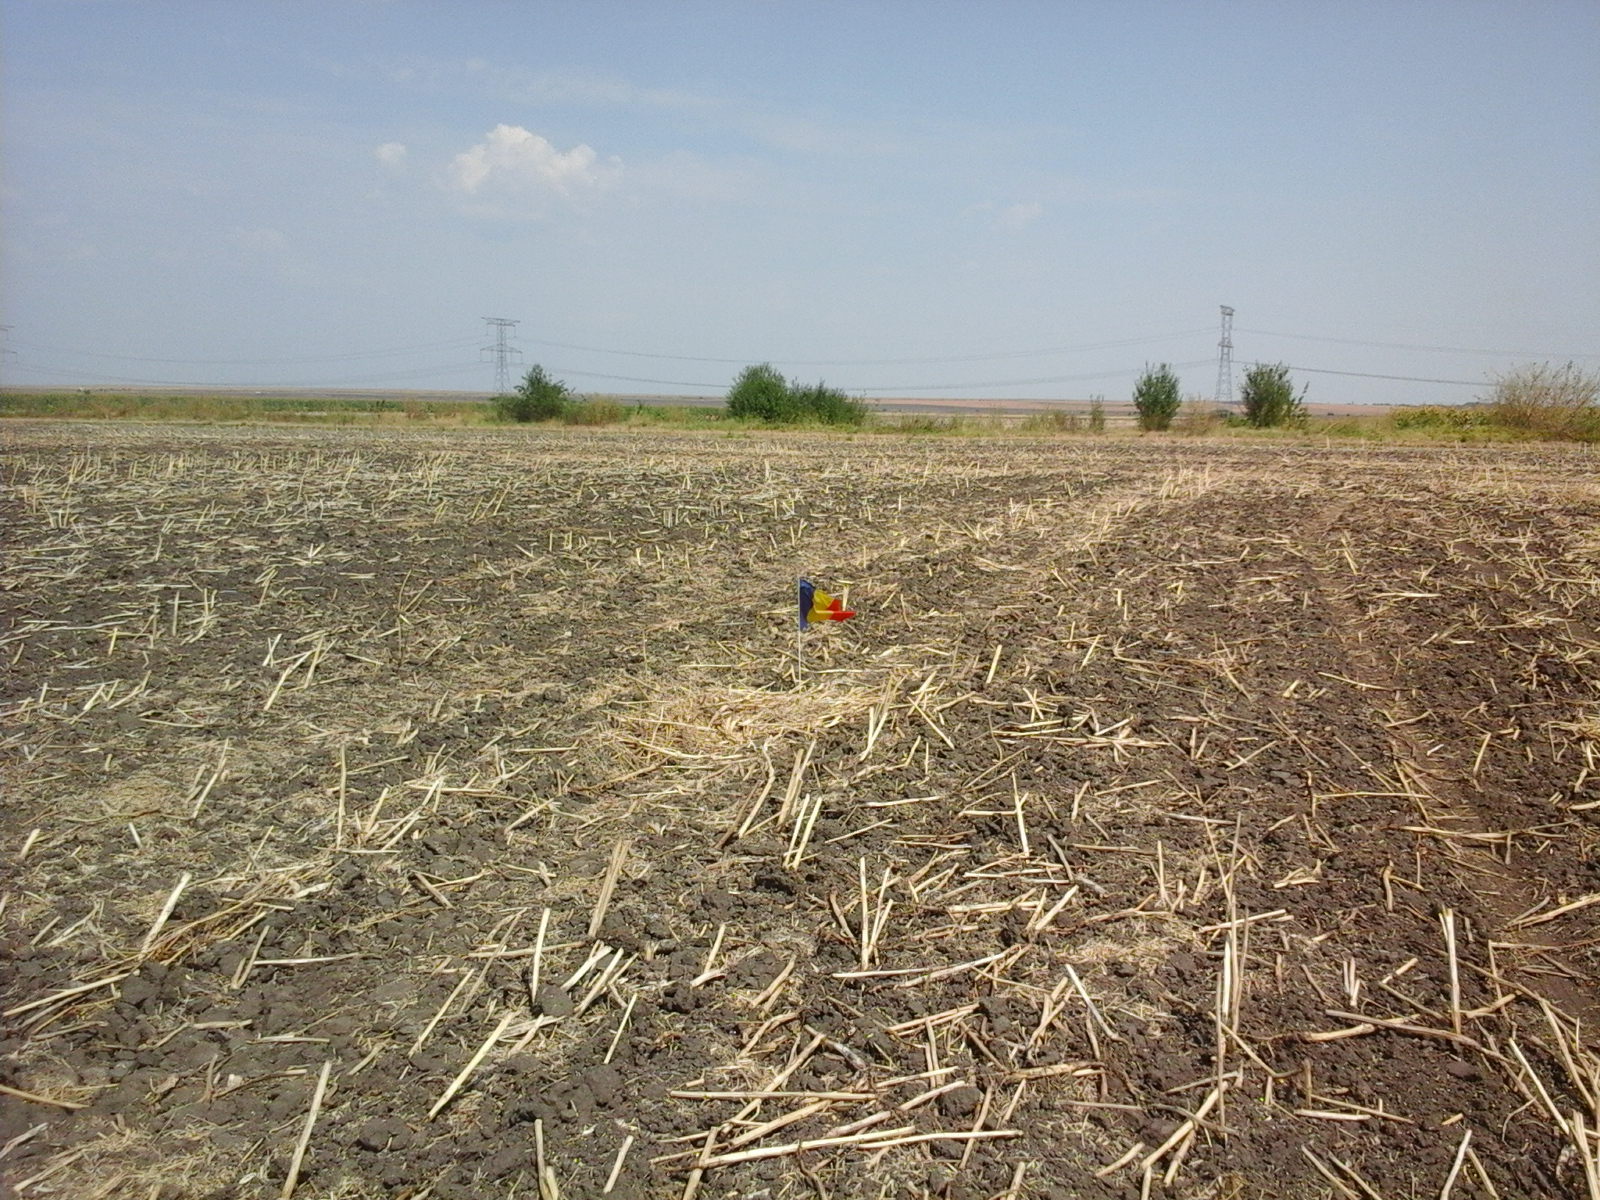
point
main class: Cropland
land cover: Rape and turnip rape
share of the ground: < 10 %
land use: Agriculture (excluding fallow land and kitchen gardens)
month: August
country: RO
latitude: 43.9203
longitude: 23.6382
